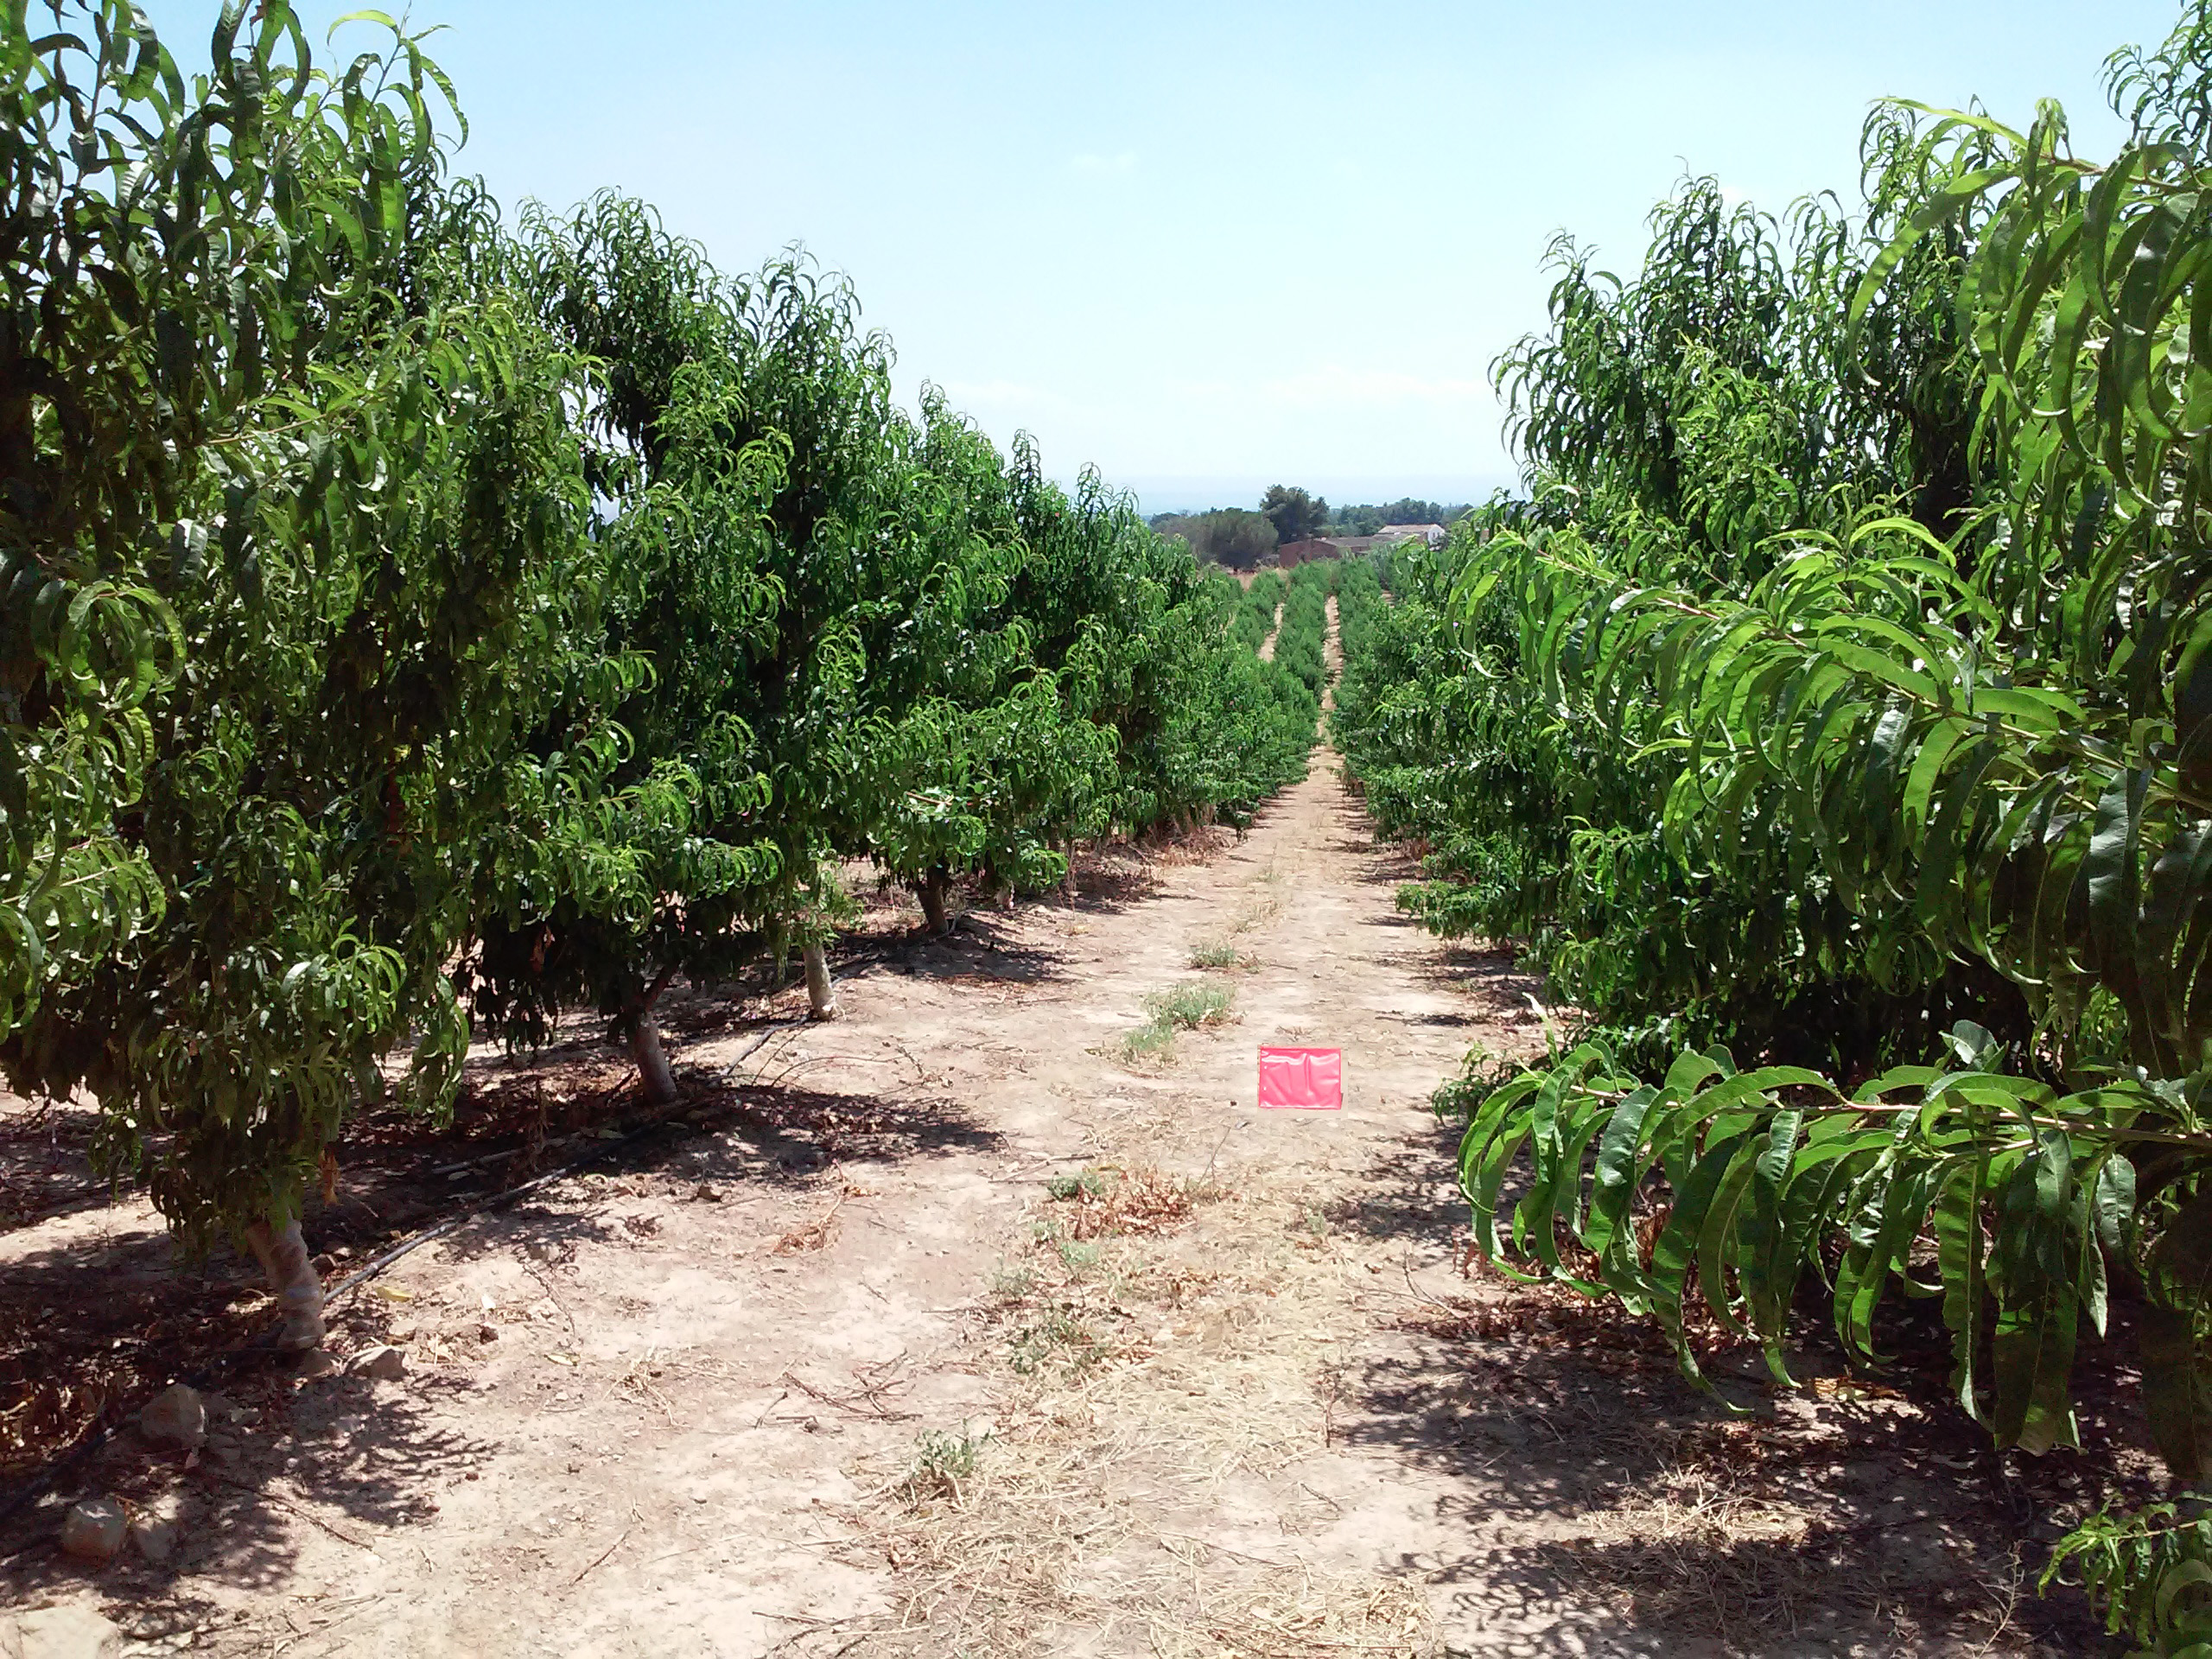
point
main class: Cropland
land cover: Other fruit trees and berries
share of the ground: 50 - 75 %
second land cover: Grassland without tree/shrub cover
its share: > 75 %
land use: Agriculture (excluding fallow land and kitchen gardens)
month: July
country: ES
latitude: 41.6467
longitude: 0.5378
